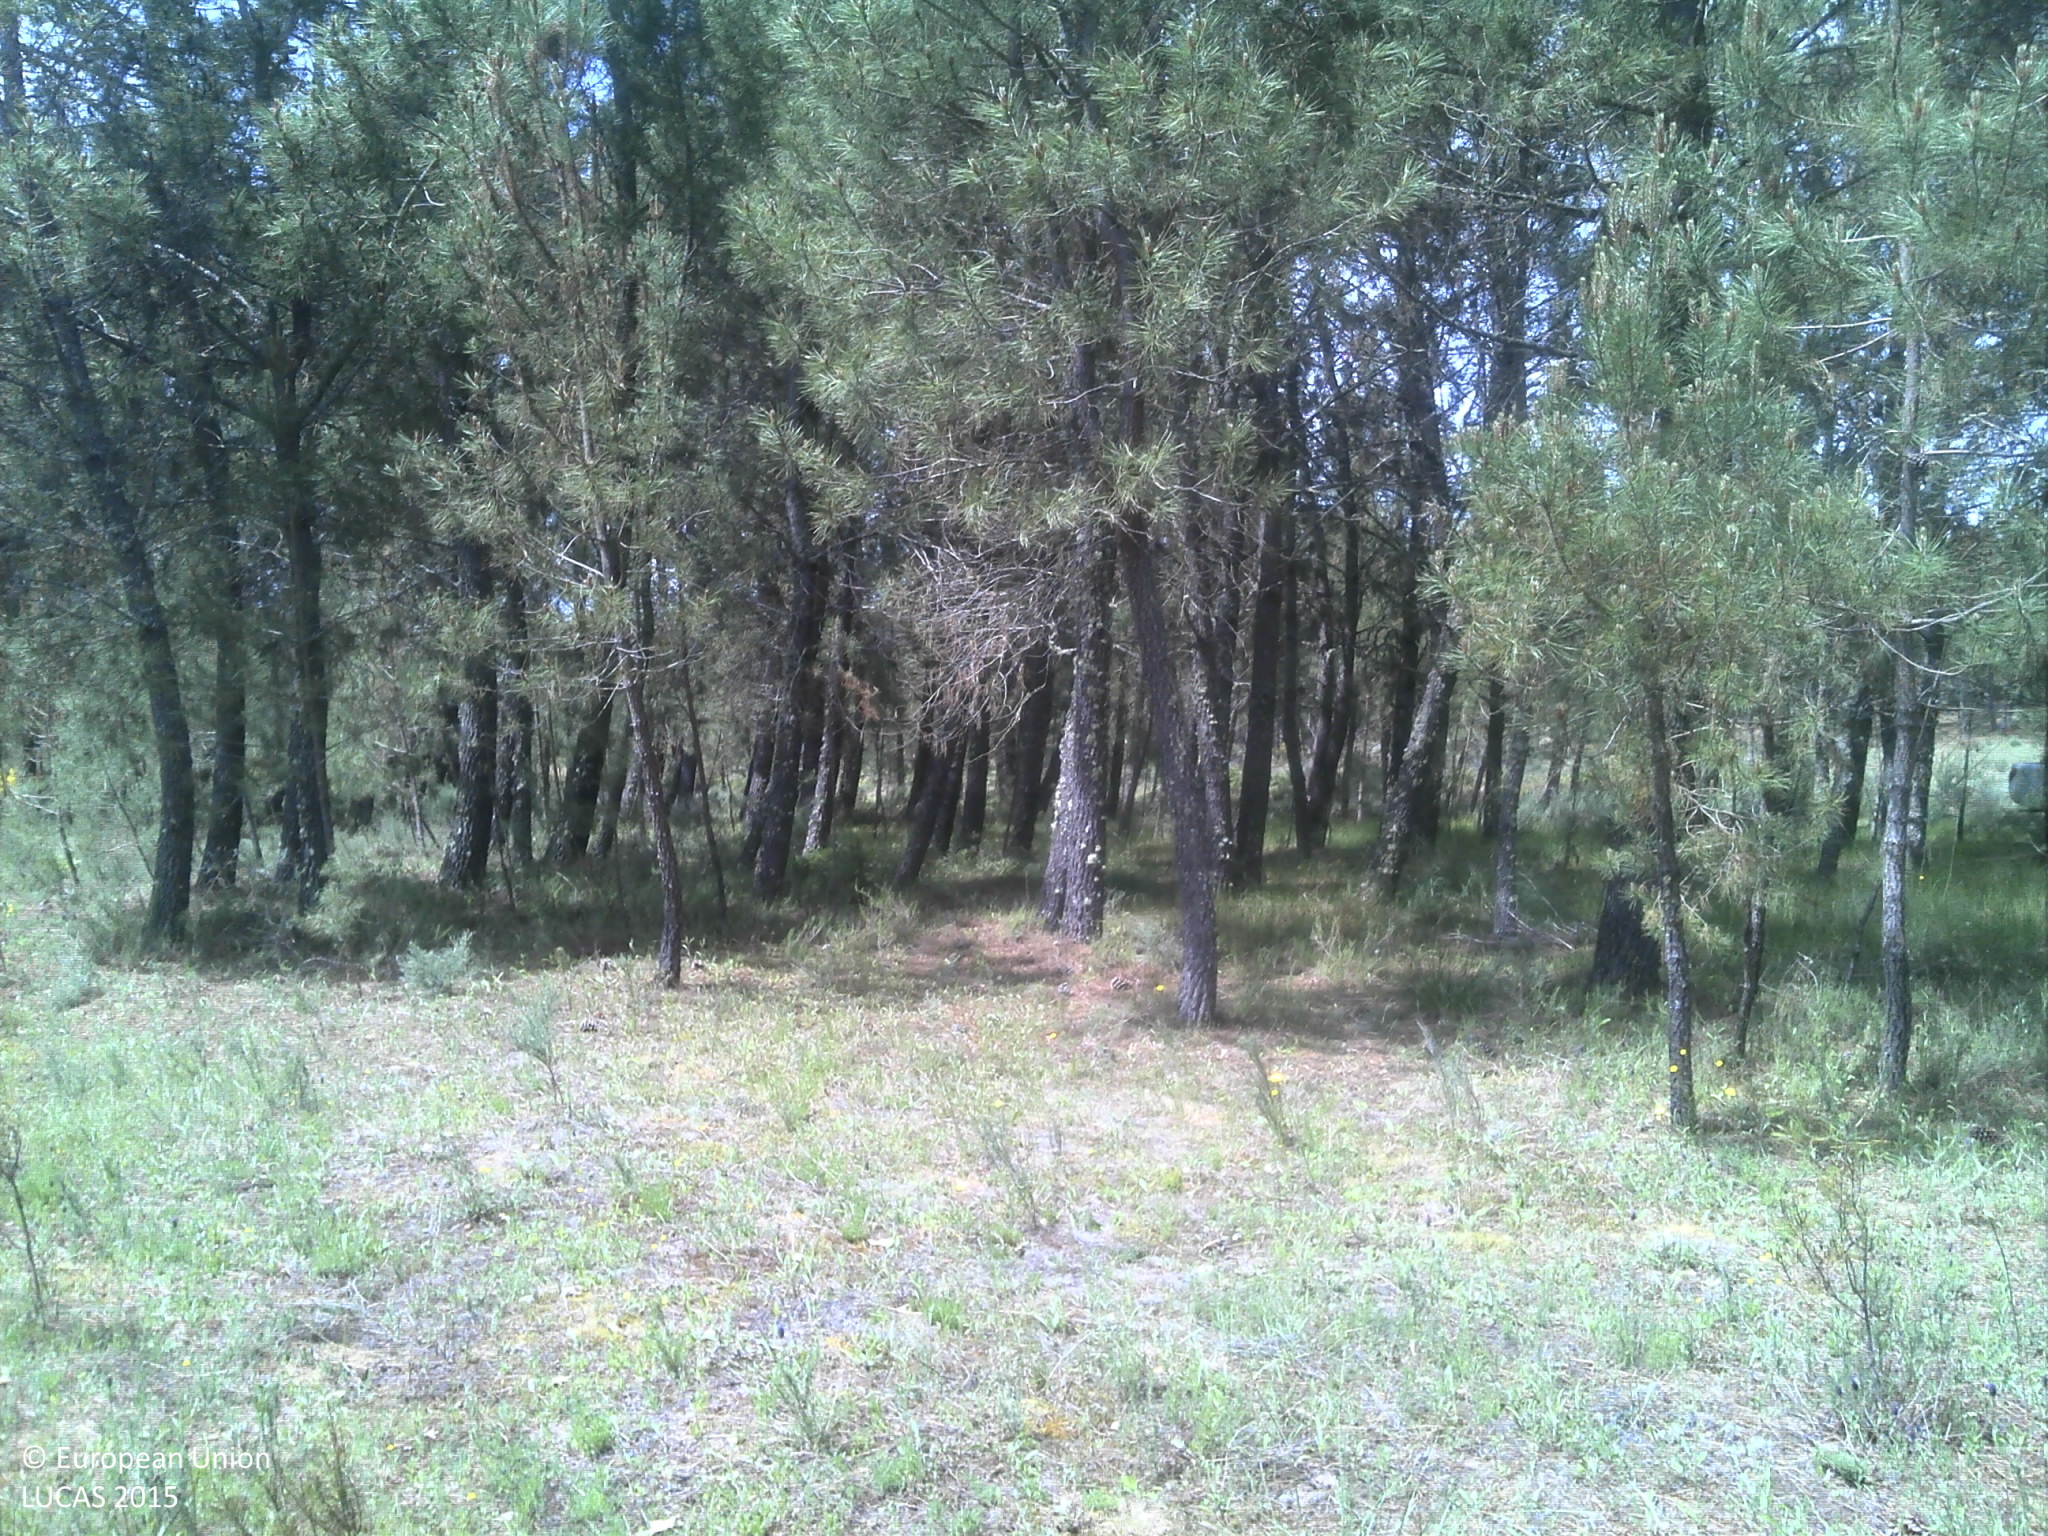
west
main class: Woodland
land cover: Pine dominated coniferous woodland
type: coniferous forest of the mediterranean region
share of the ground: 25 - 50 %
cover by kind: coniferous forest trees 50 %, shrubs 20 %, herbaceous plants 15 %, unconsolidated bare surface 15 %
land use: Forestry
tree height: > 5 m
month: May
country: PT
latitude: 40.7143
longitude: -7.4797
